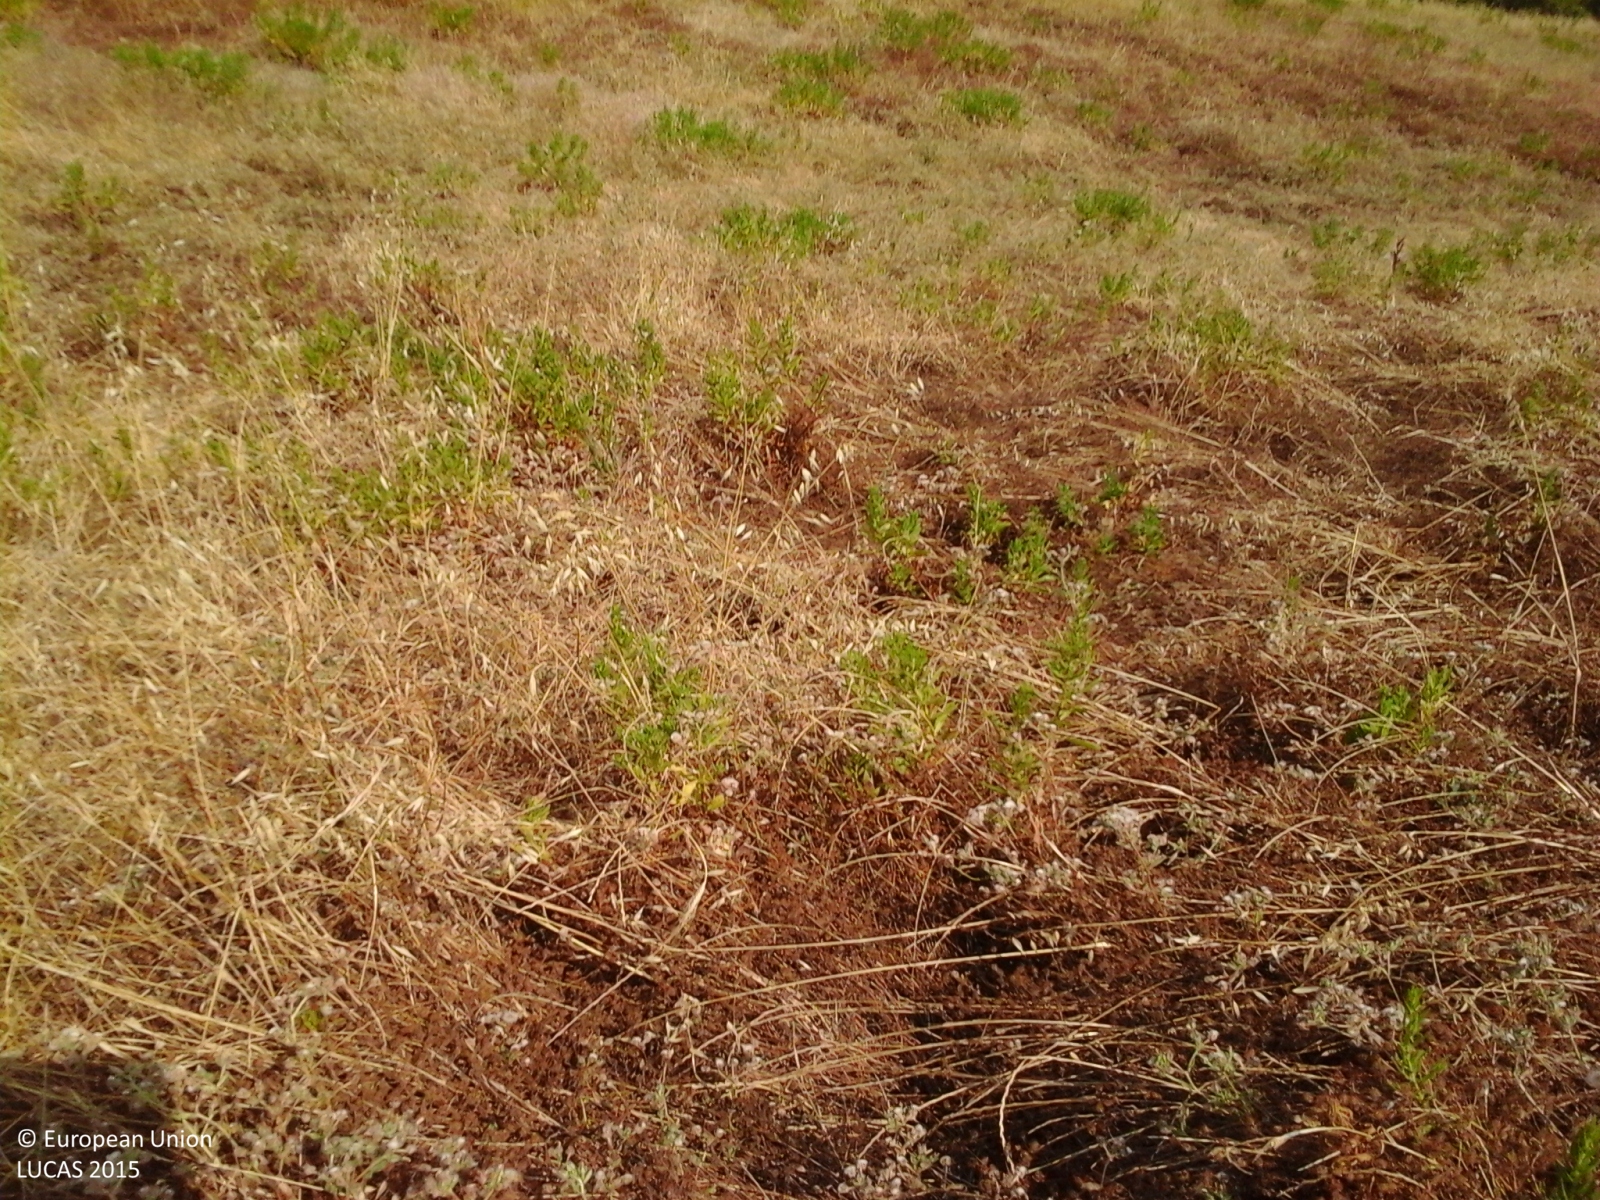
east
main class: Cropland
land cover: Temporary grasslands
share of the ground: > 75 %
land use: Agriculture (excluding fallow land and kitchen gardens)
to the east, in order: Temporary grasslands; Oats; Groves; Broadleaved woodland; Rocks and stones; Broadleaved woodland
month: July
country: IT
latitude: 43.1481
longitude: 11.5325
